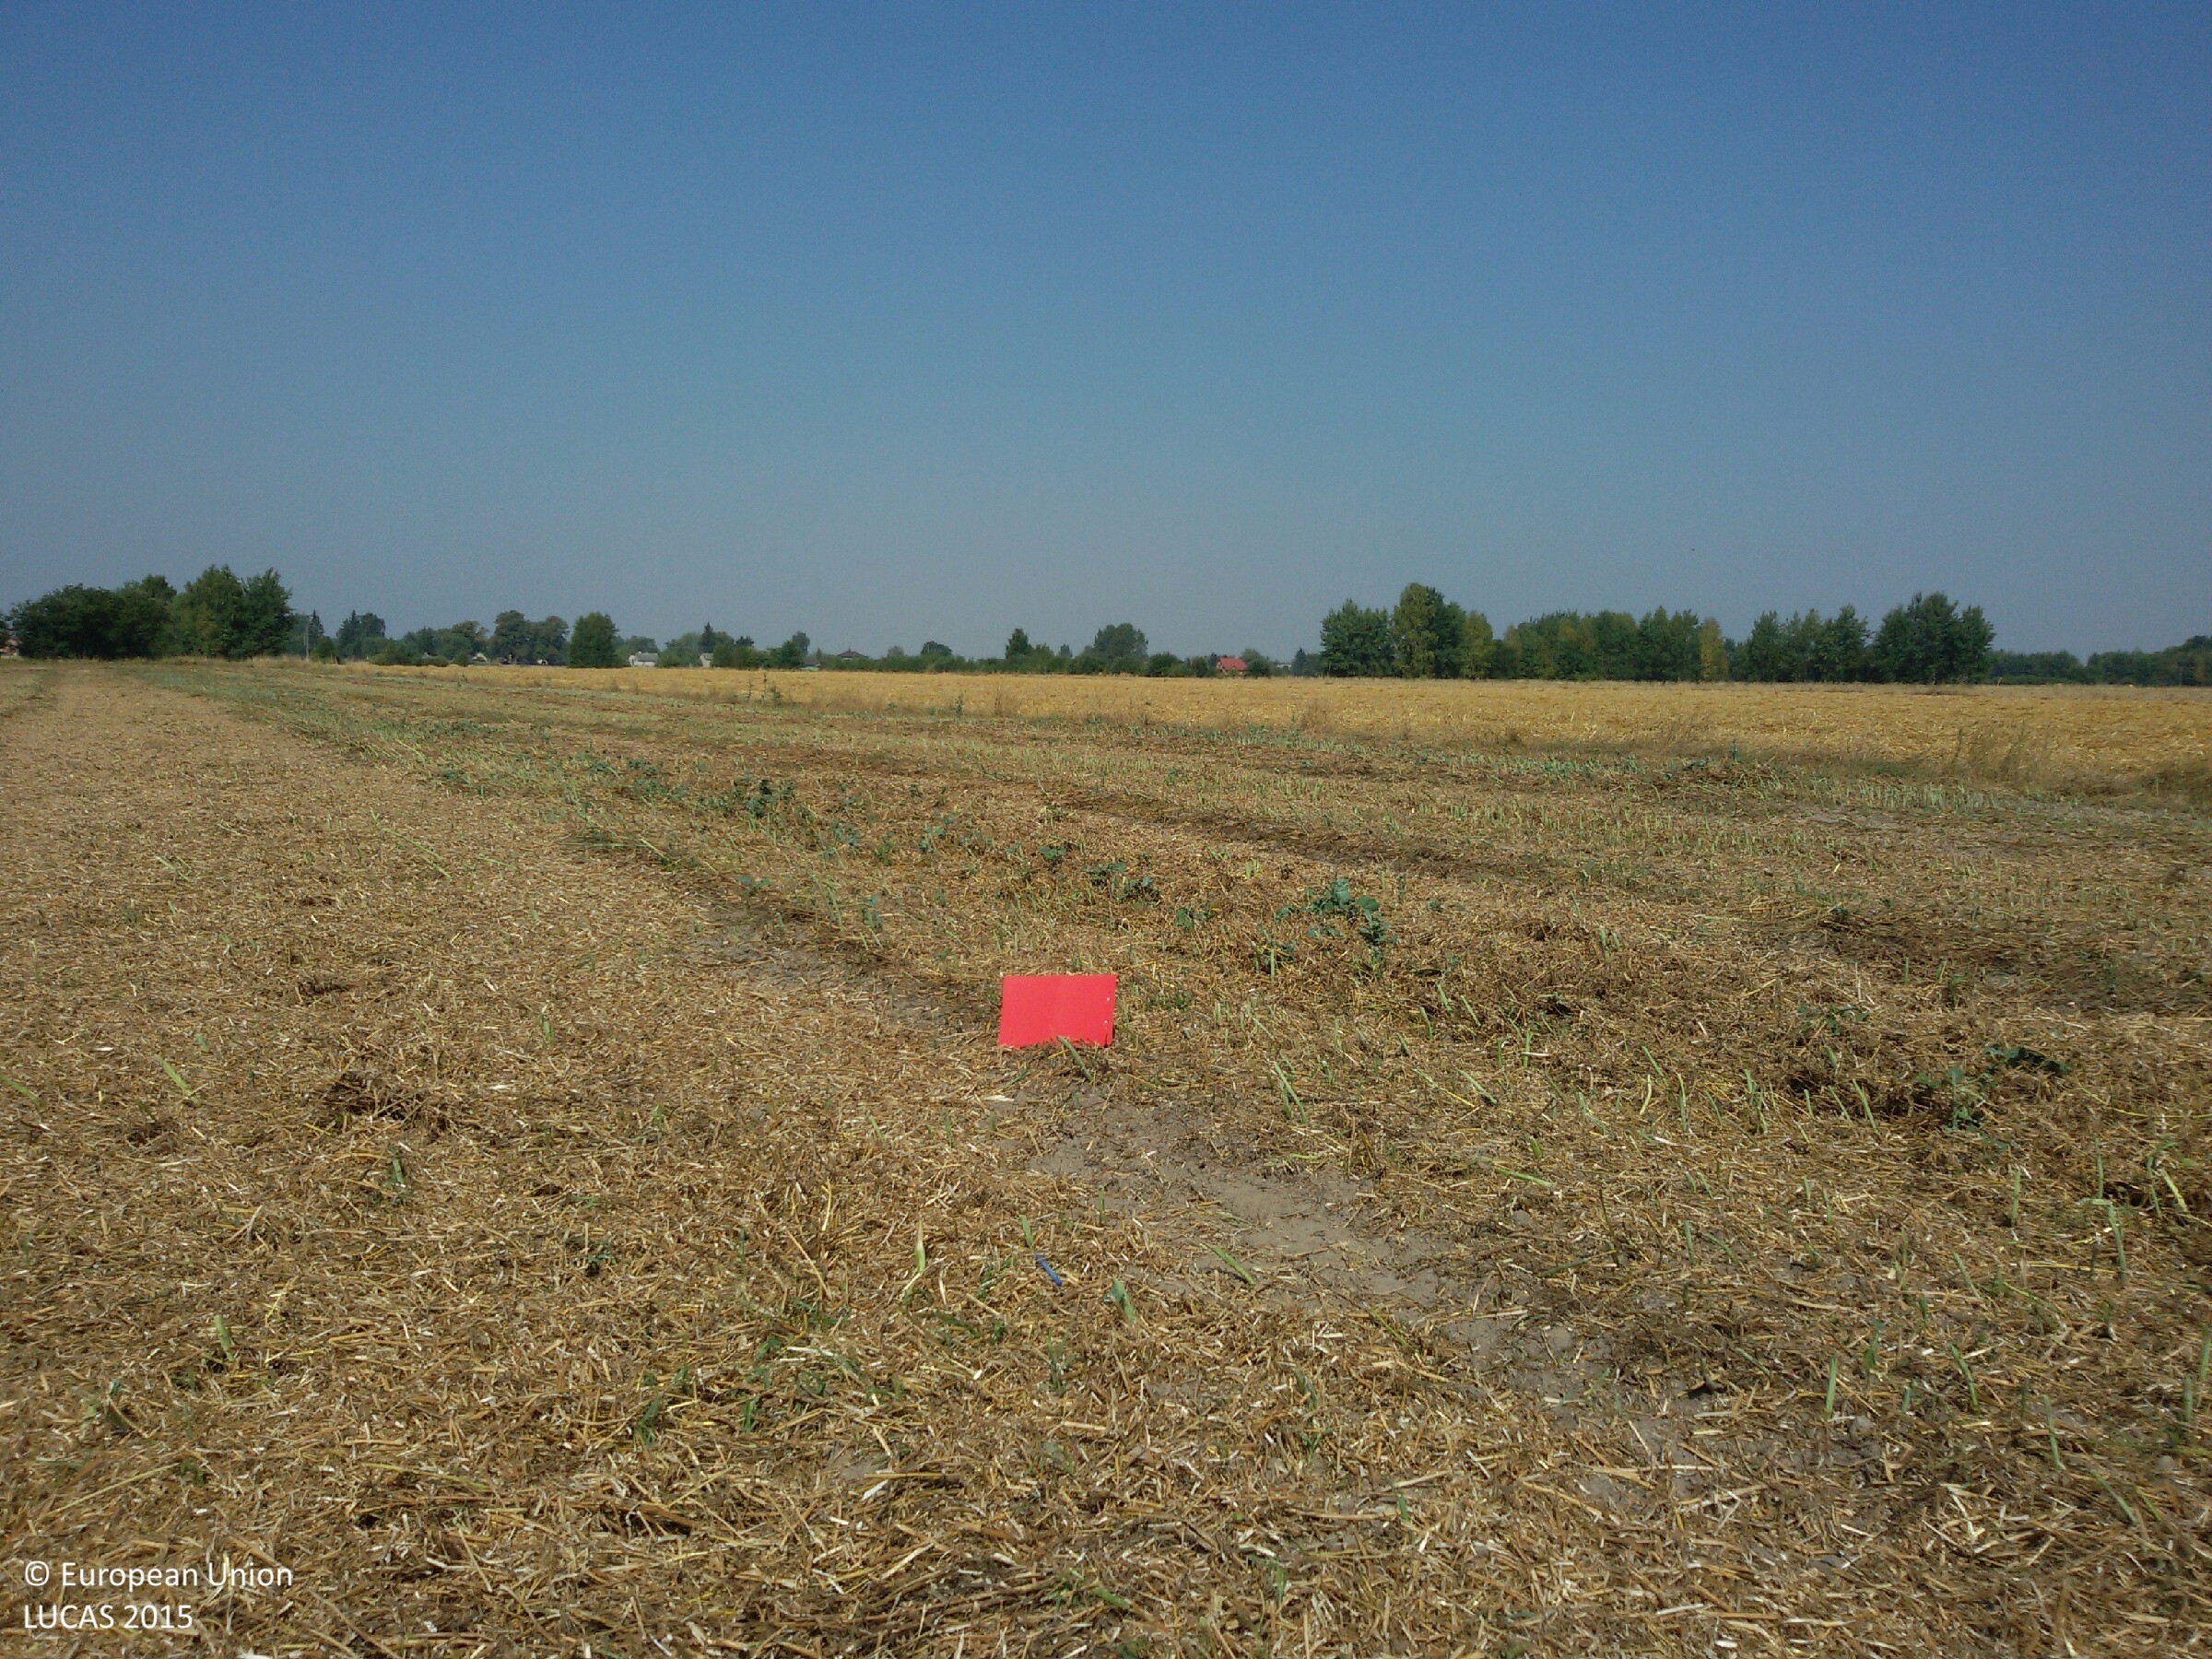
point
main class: Cropland
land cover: Barley
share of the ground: 50 - 75 %
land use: Agriculture (excluding fallow land and kitchen gardens)
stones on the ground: < 10 %
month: August
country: PL
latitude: 51.6763
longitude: 22.8418
